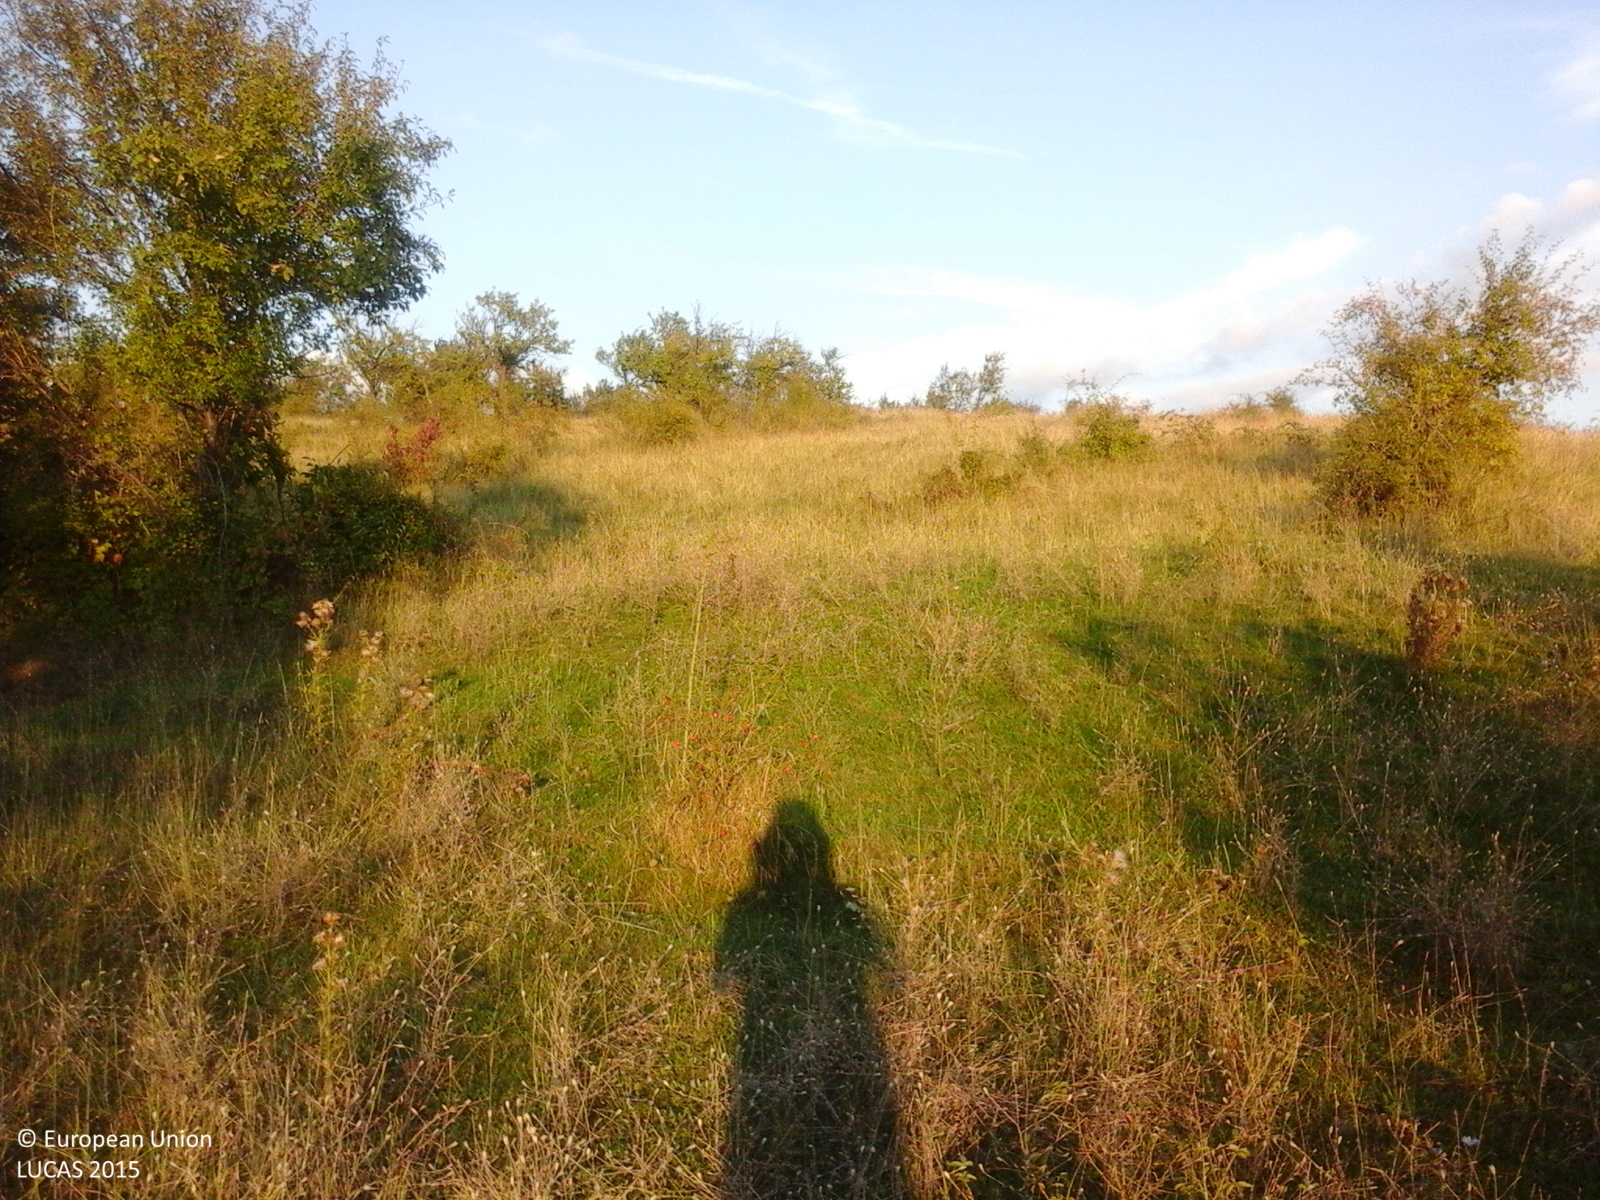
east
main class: Grassland
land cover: Grassland with sparse tree/shrub cover
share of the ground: > 75 %
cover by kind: herbaceous plants 85 %, shrubs 10 %, broadleaved forest trees 5 %
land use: Agriculture (excluding fallow land and kitchen gardens)
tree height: > 5 m
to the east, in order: Grassland with sparse tree/shrub cover; Tracks; Grassland with sparse tree/shrub cover; Grassland without tree/shrub cover; Abandoned hedges
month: September
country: RO
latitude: 45.1083
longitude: 23.4923
